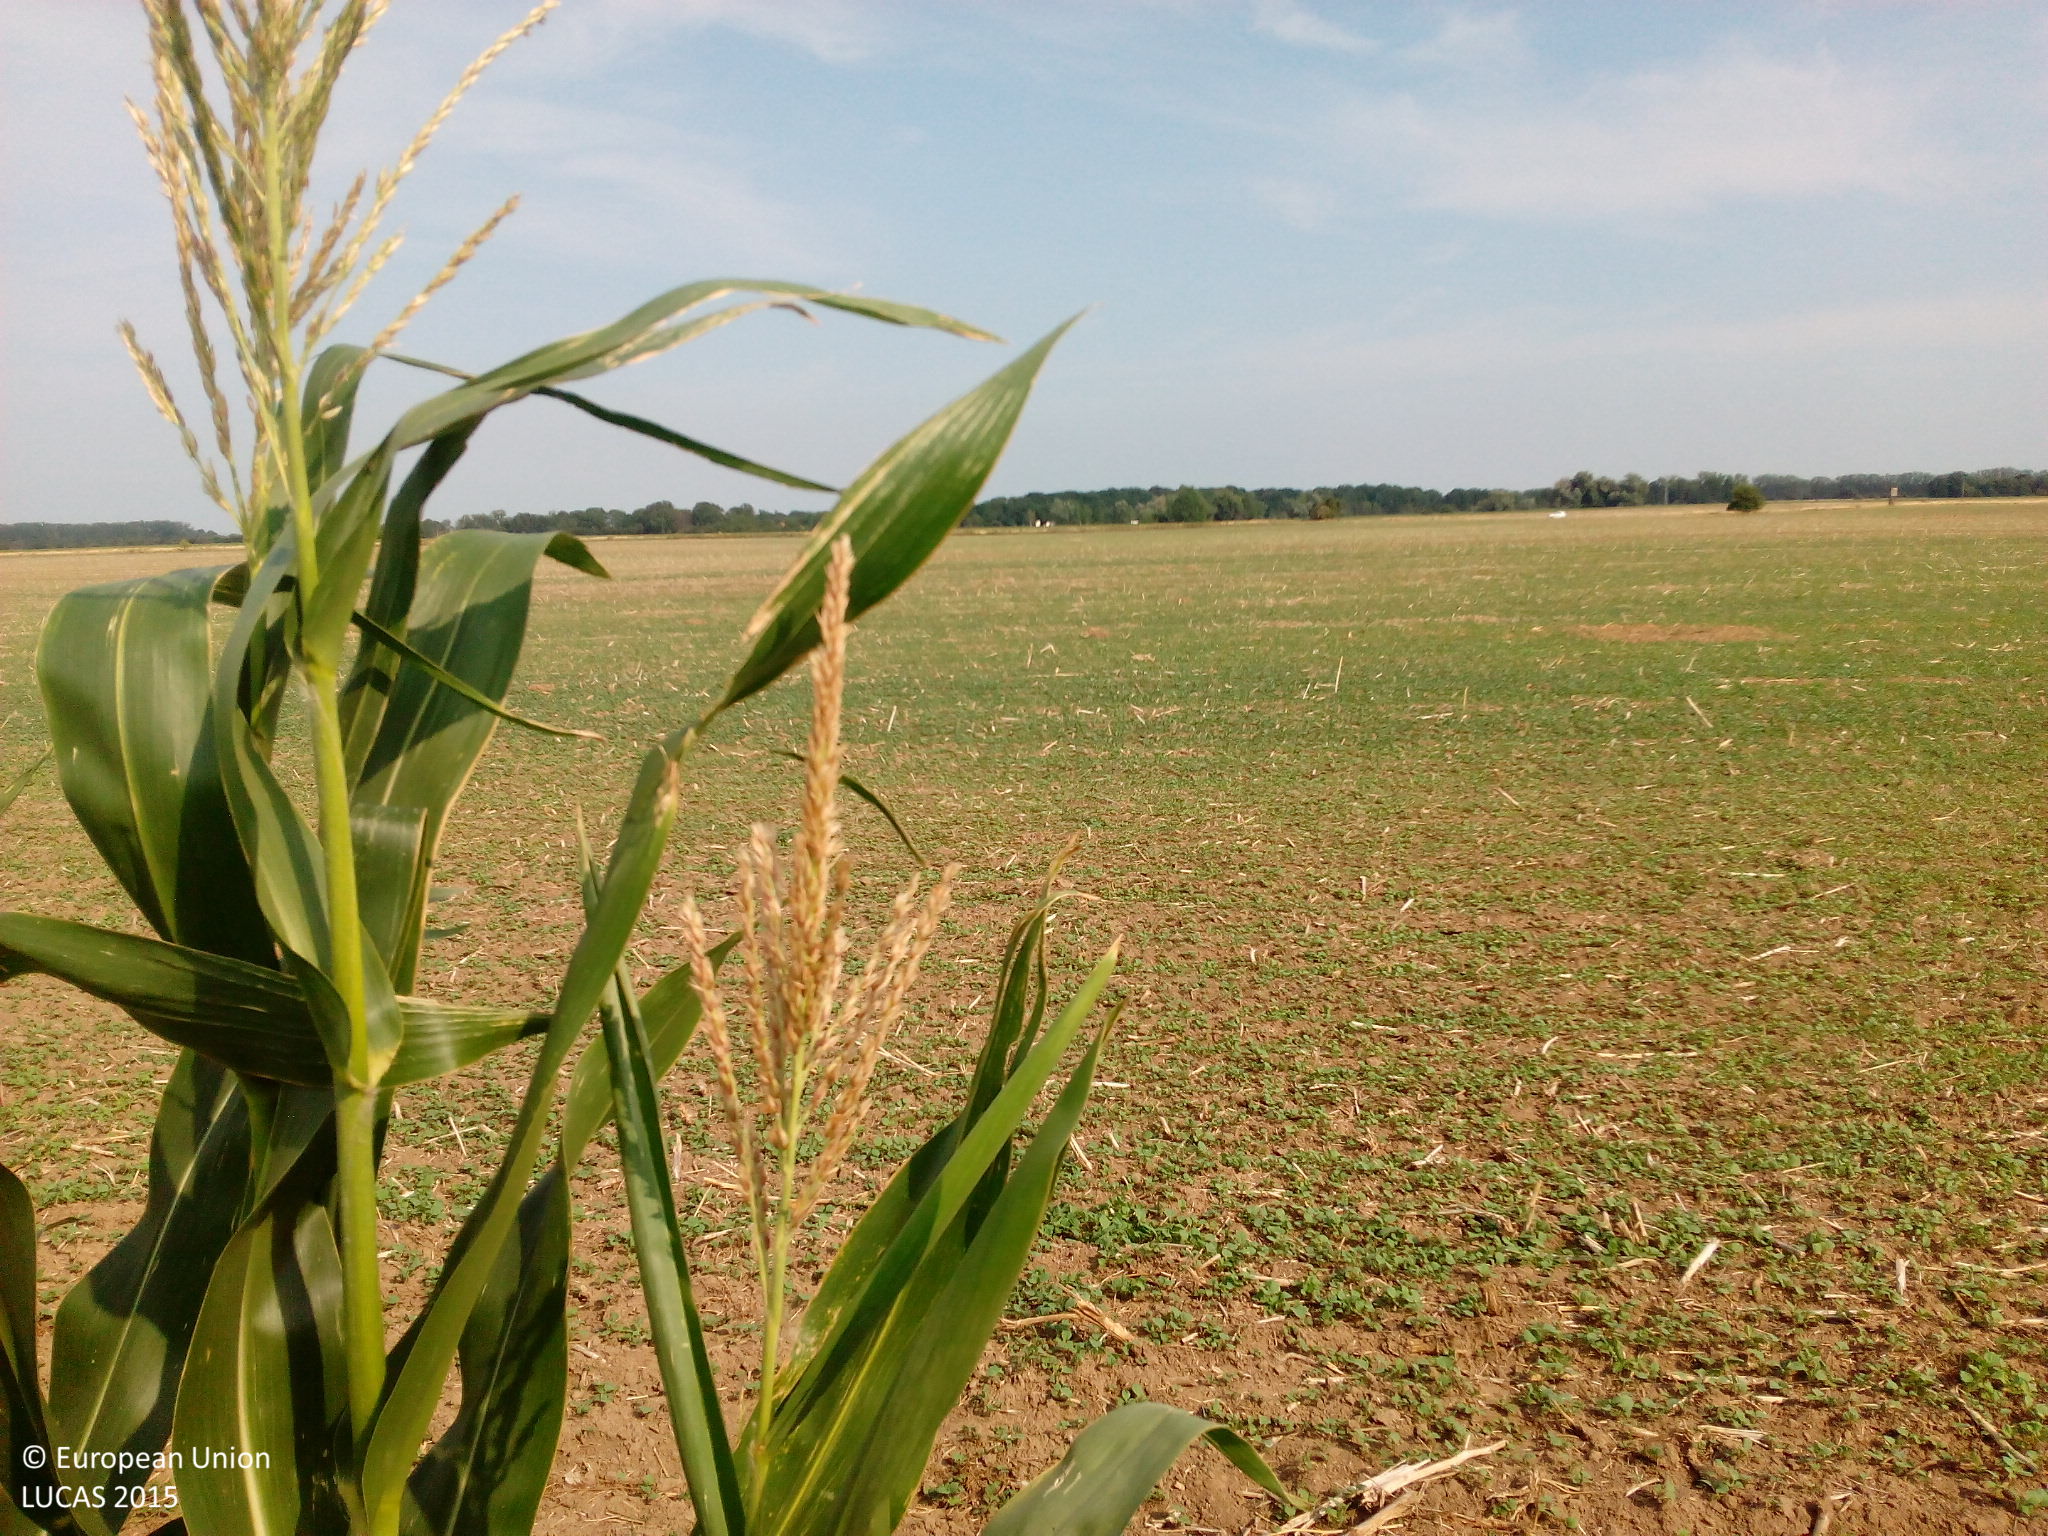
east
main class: Cropland
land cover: Maize
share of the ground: > 75 %
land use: Agriculture (excluding fallow land and kitchen gardens)
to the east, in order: Maize; Rape and turnip rape
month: August
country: DE
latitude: 52.9220
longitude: 11.7397
